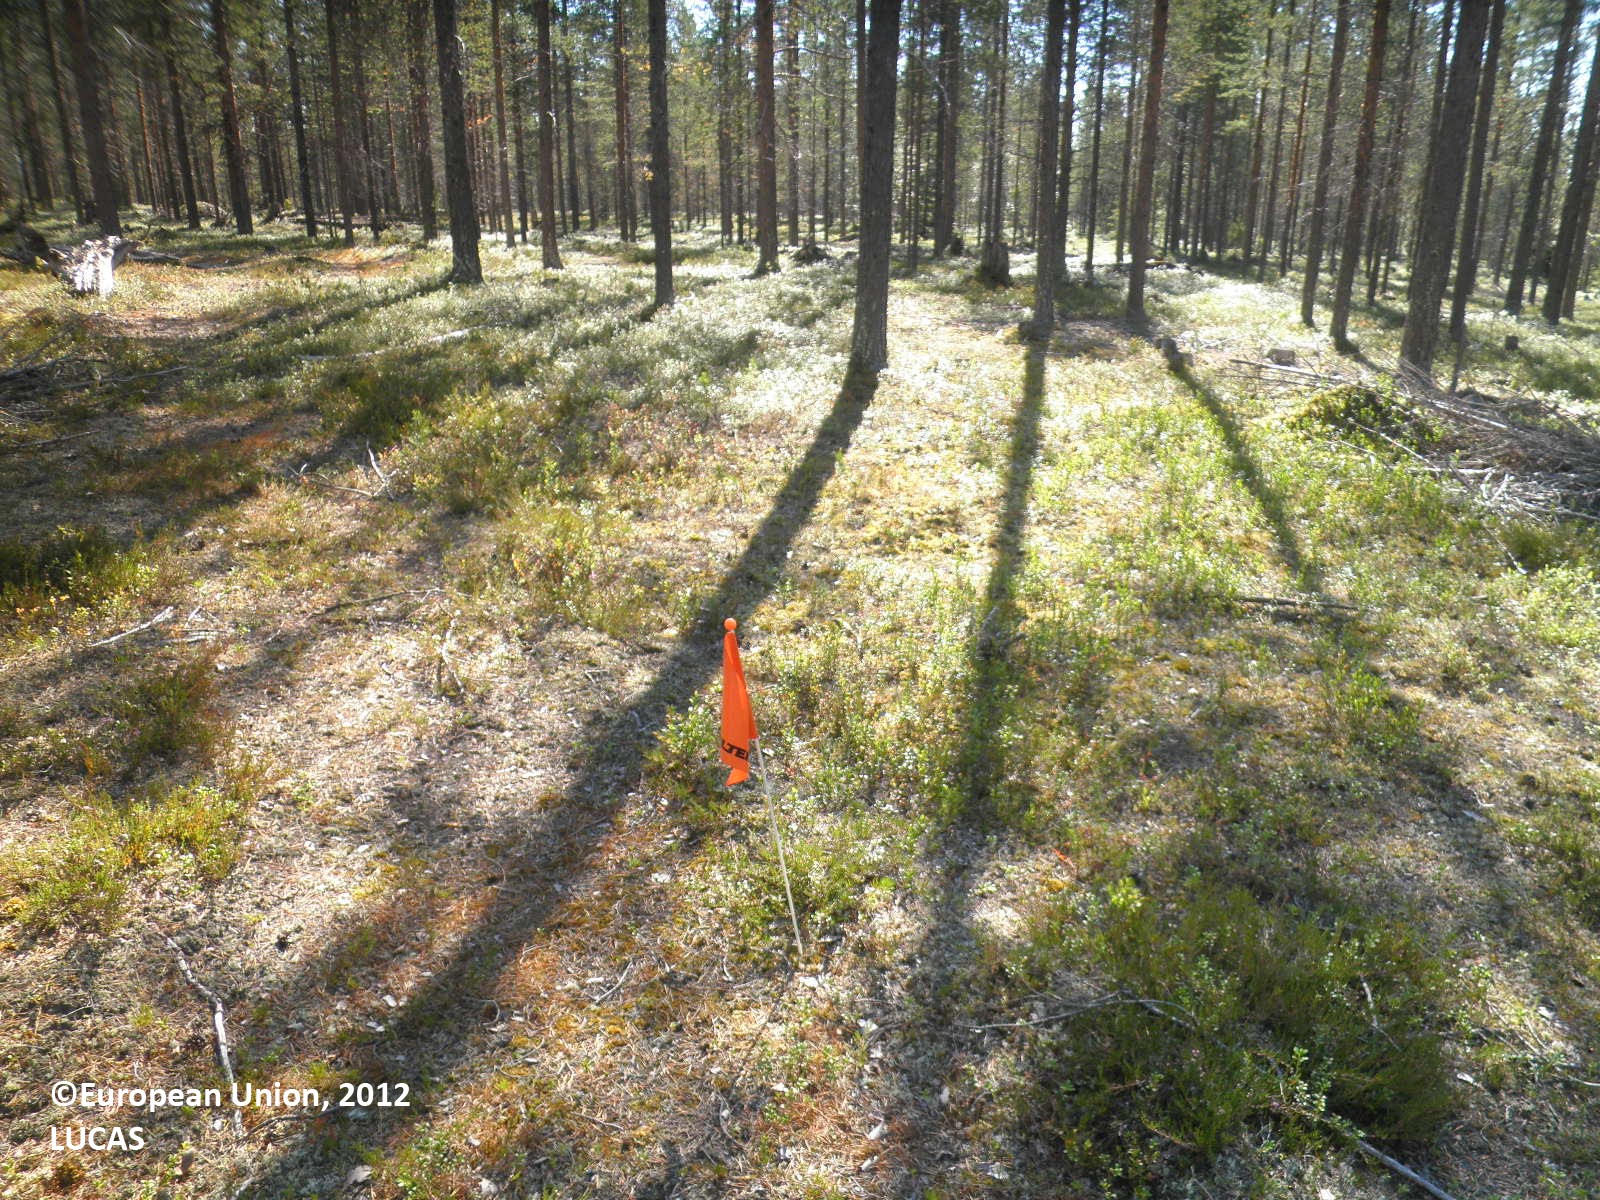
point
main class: Woodland
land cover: Pine dominated coniferous woodland
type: boreal forest
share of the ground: 25 - 50 %
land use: Forestry
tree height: > 5 m
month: August
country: FI
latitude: 67.7313
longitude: 25.6315
